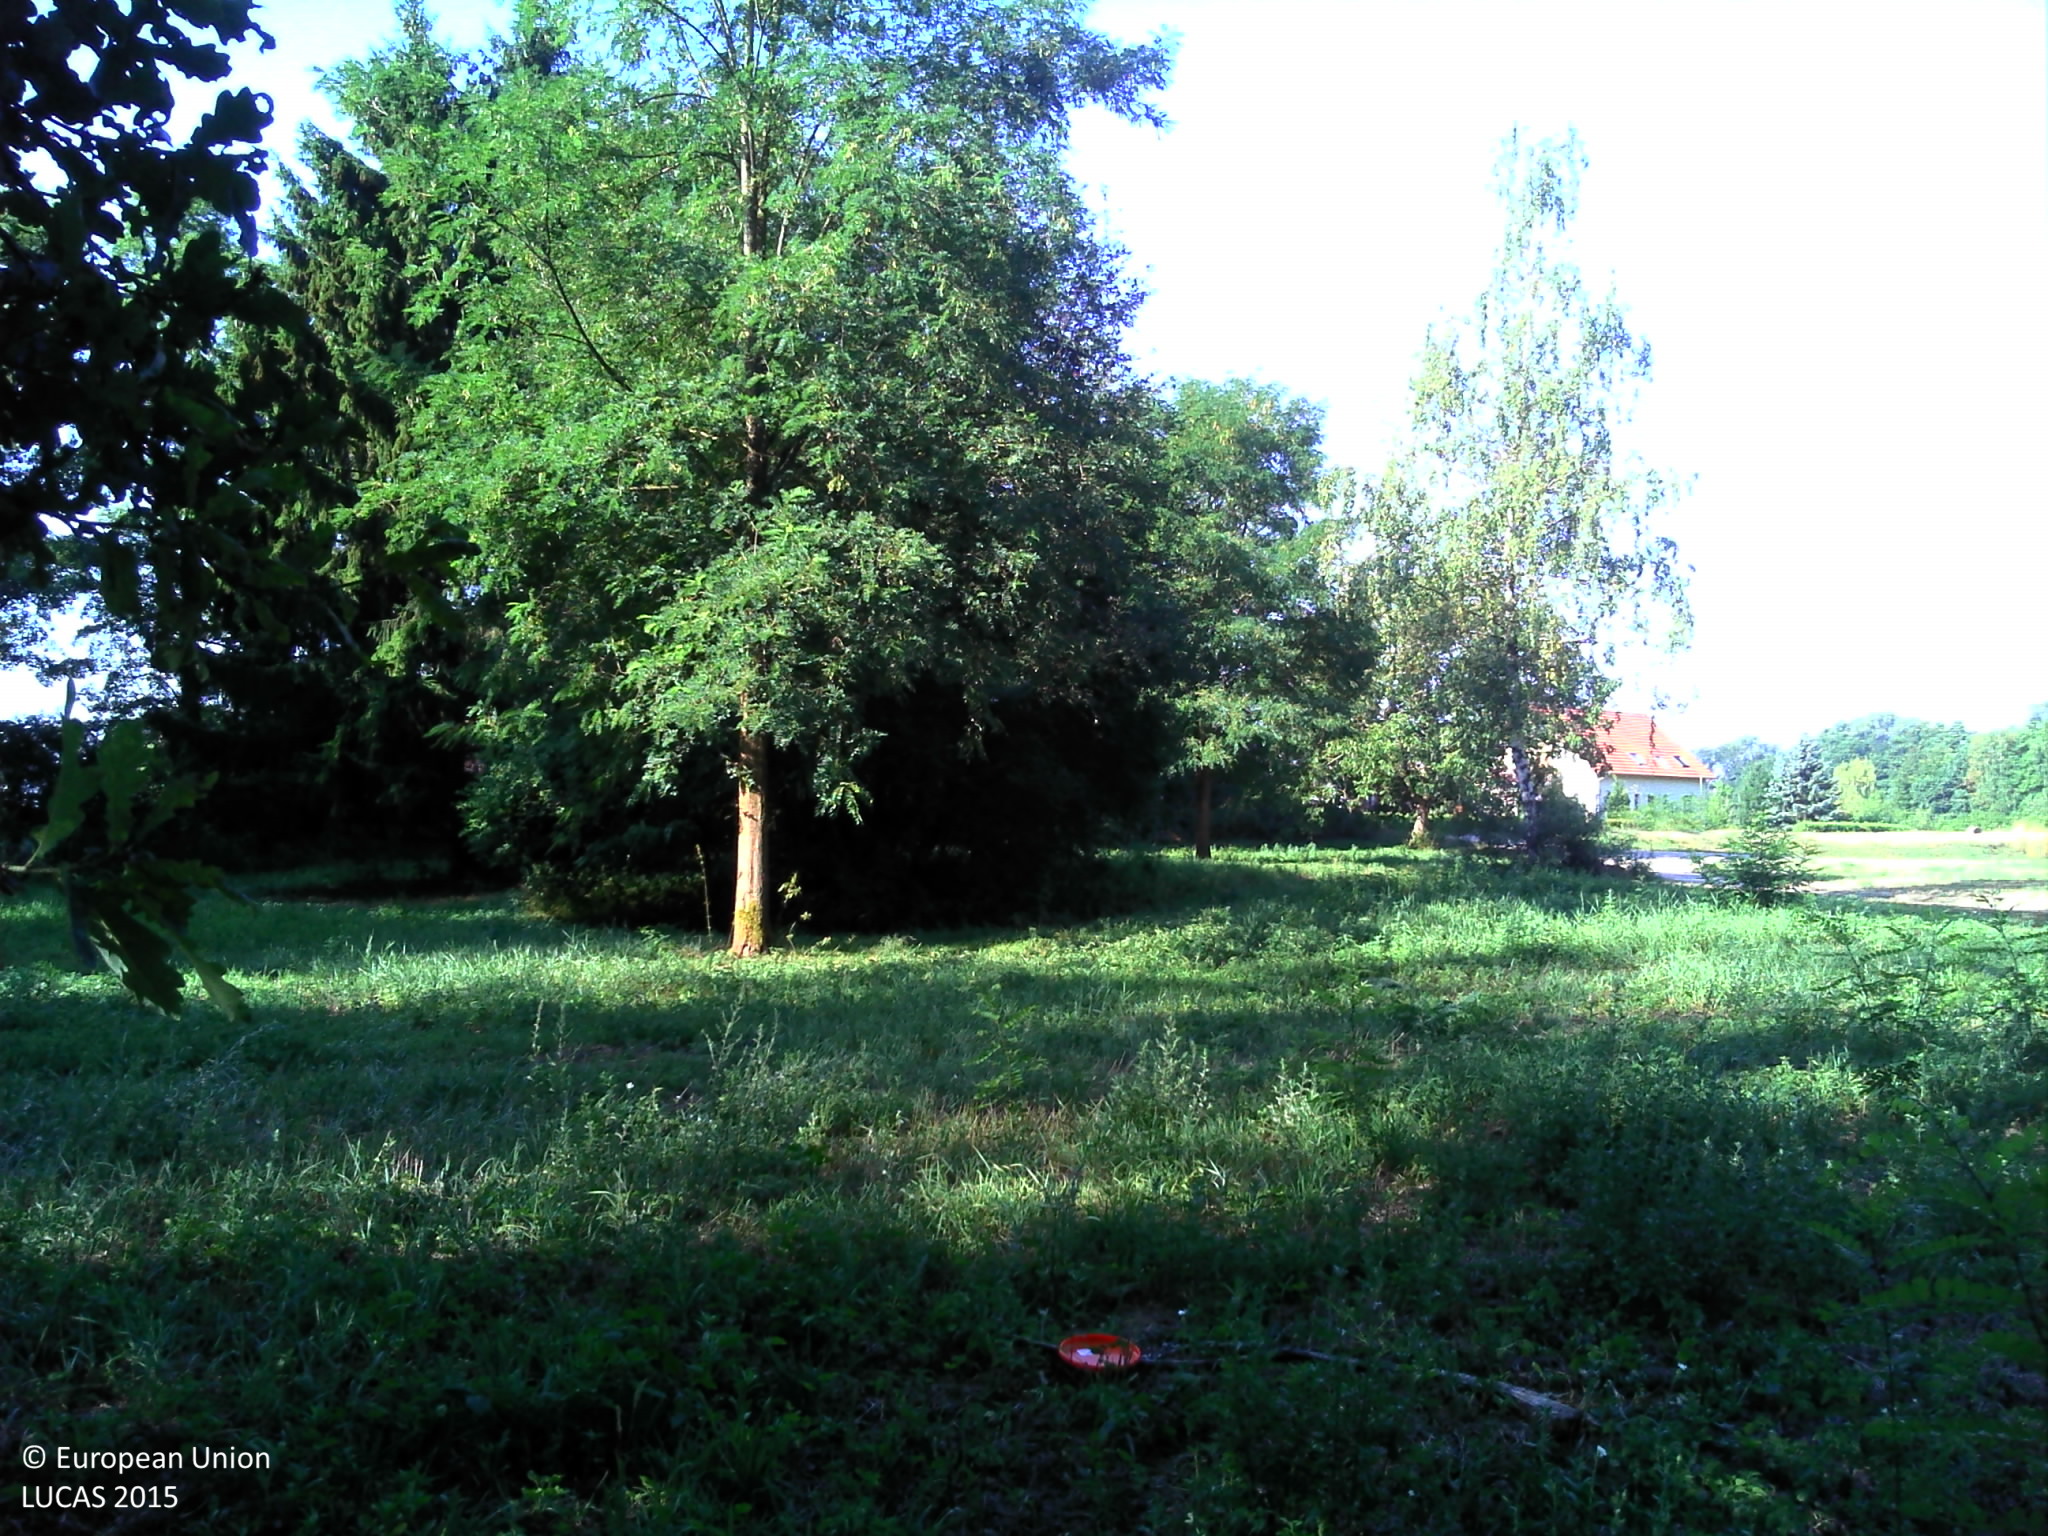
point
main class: Woodland
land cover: Broadleaved woodland
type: mesophytic deciduous forest
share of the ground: > 75 %
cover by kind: broadleaved forest trees 50 %, herbaceous plants 50 %
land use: Forestry
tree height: > 5 m
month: August
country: FR
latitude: 48.8348
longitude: 7.9708
